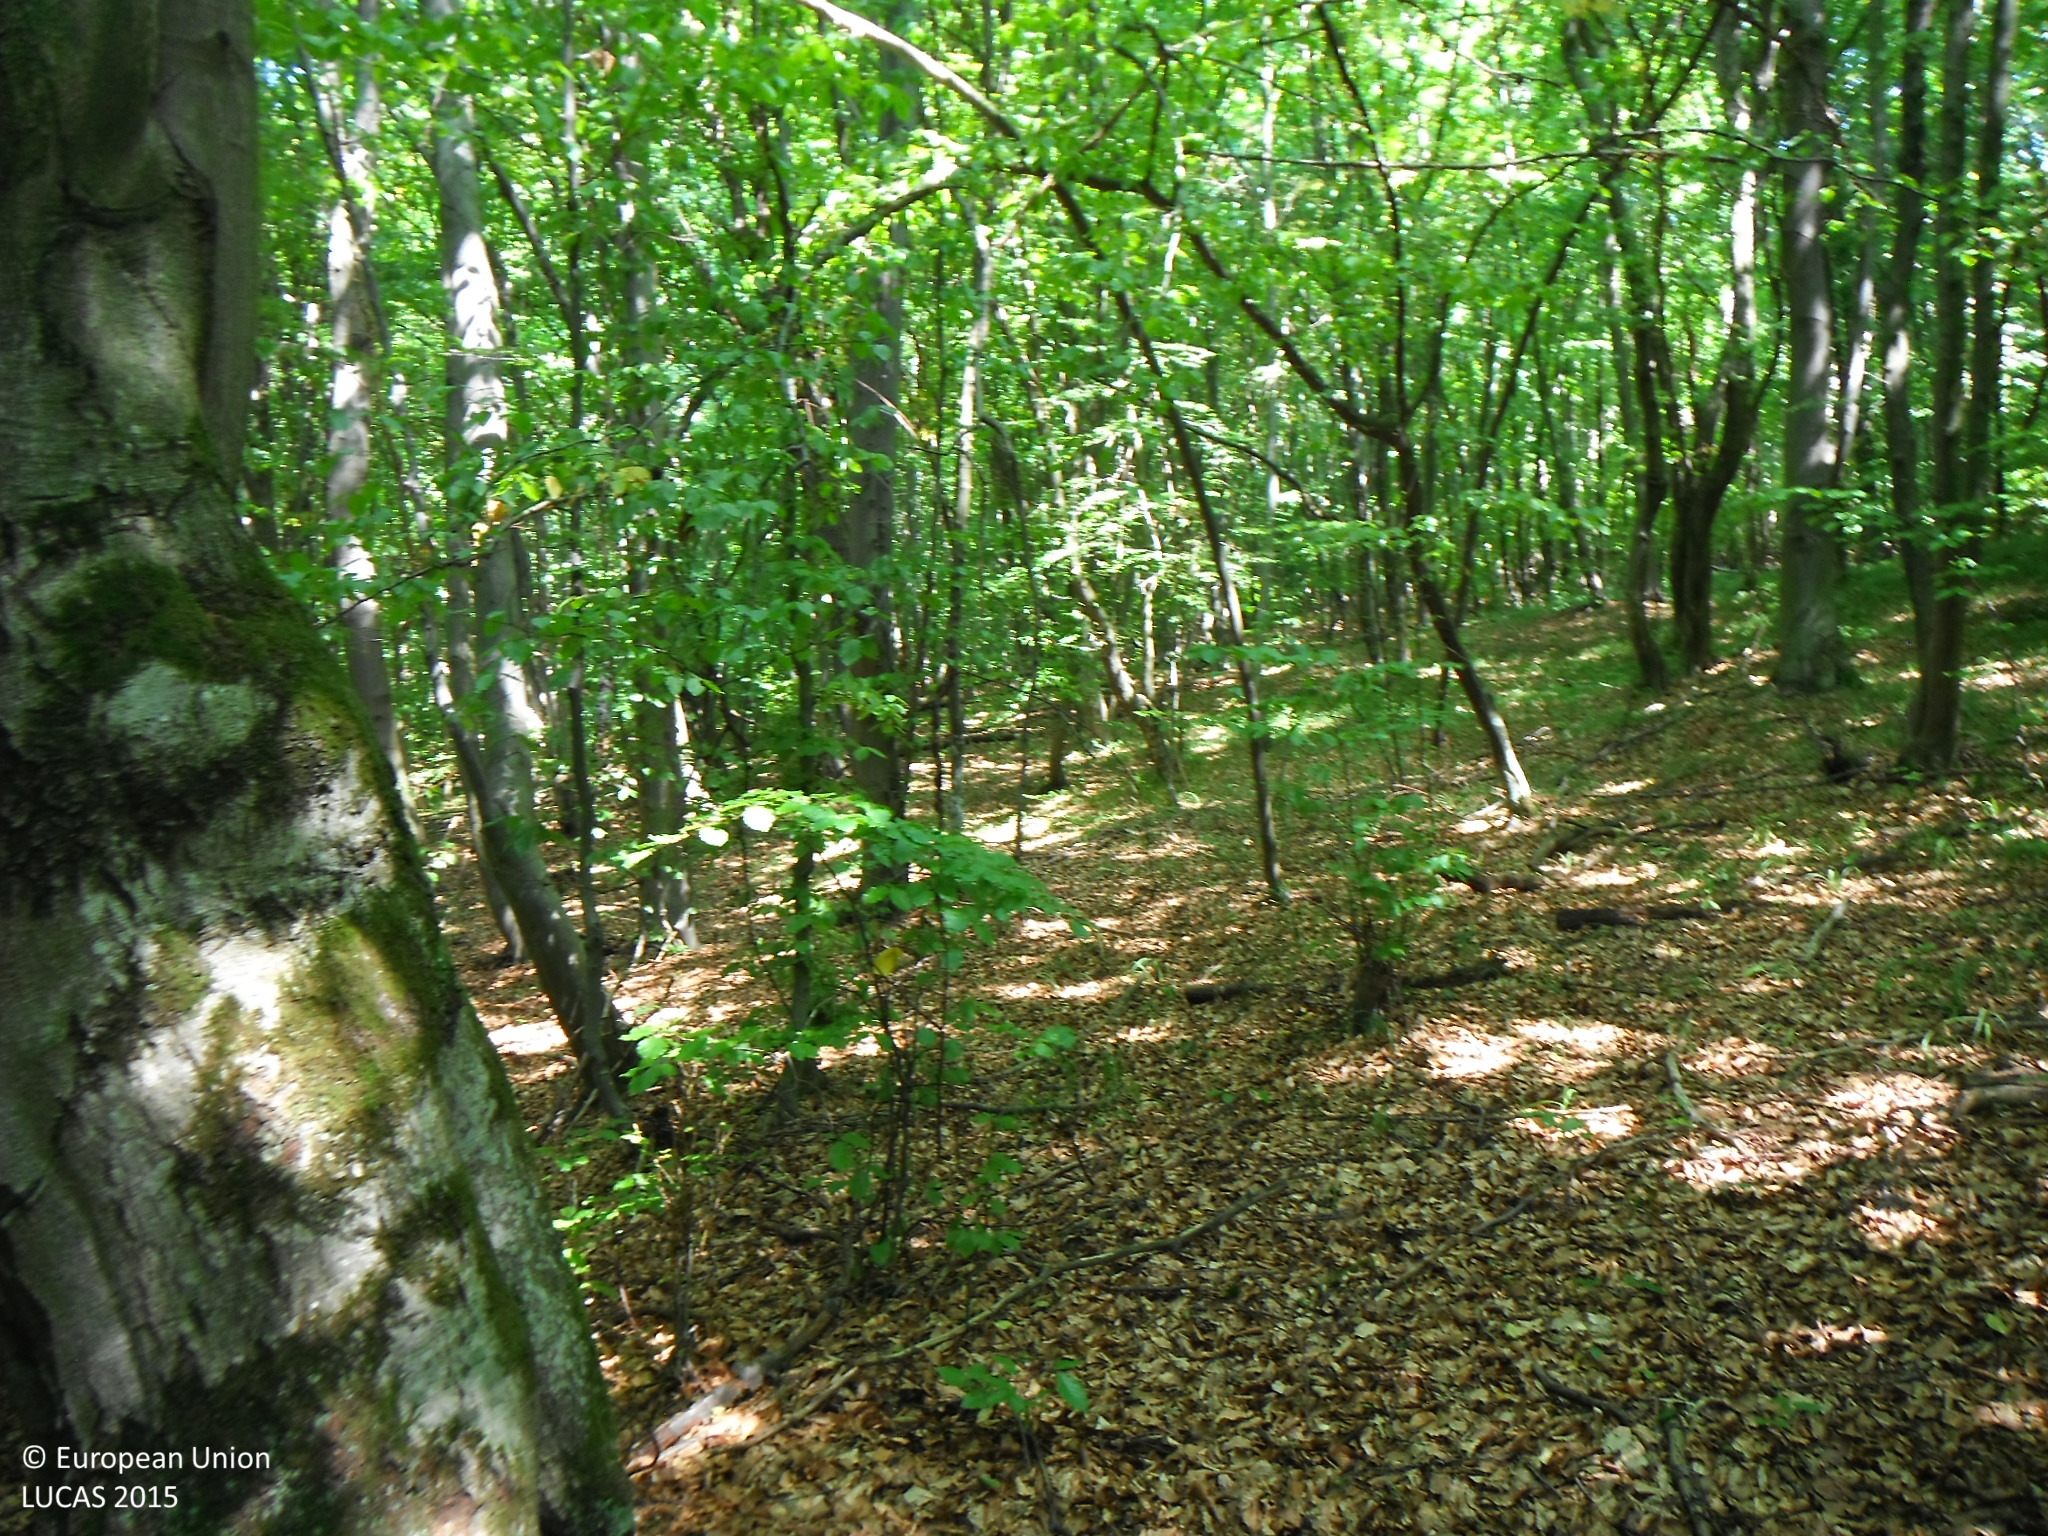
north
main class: Woodland
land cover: Broadleaved woodland
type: mesophytic deciduous forest
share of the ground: > 75 %
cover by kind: broadleaved forest trees 100 %
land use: Forestry
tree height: > 5 m
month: August
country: SK
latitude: 49.1509
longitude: 21.9698
